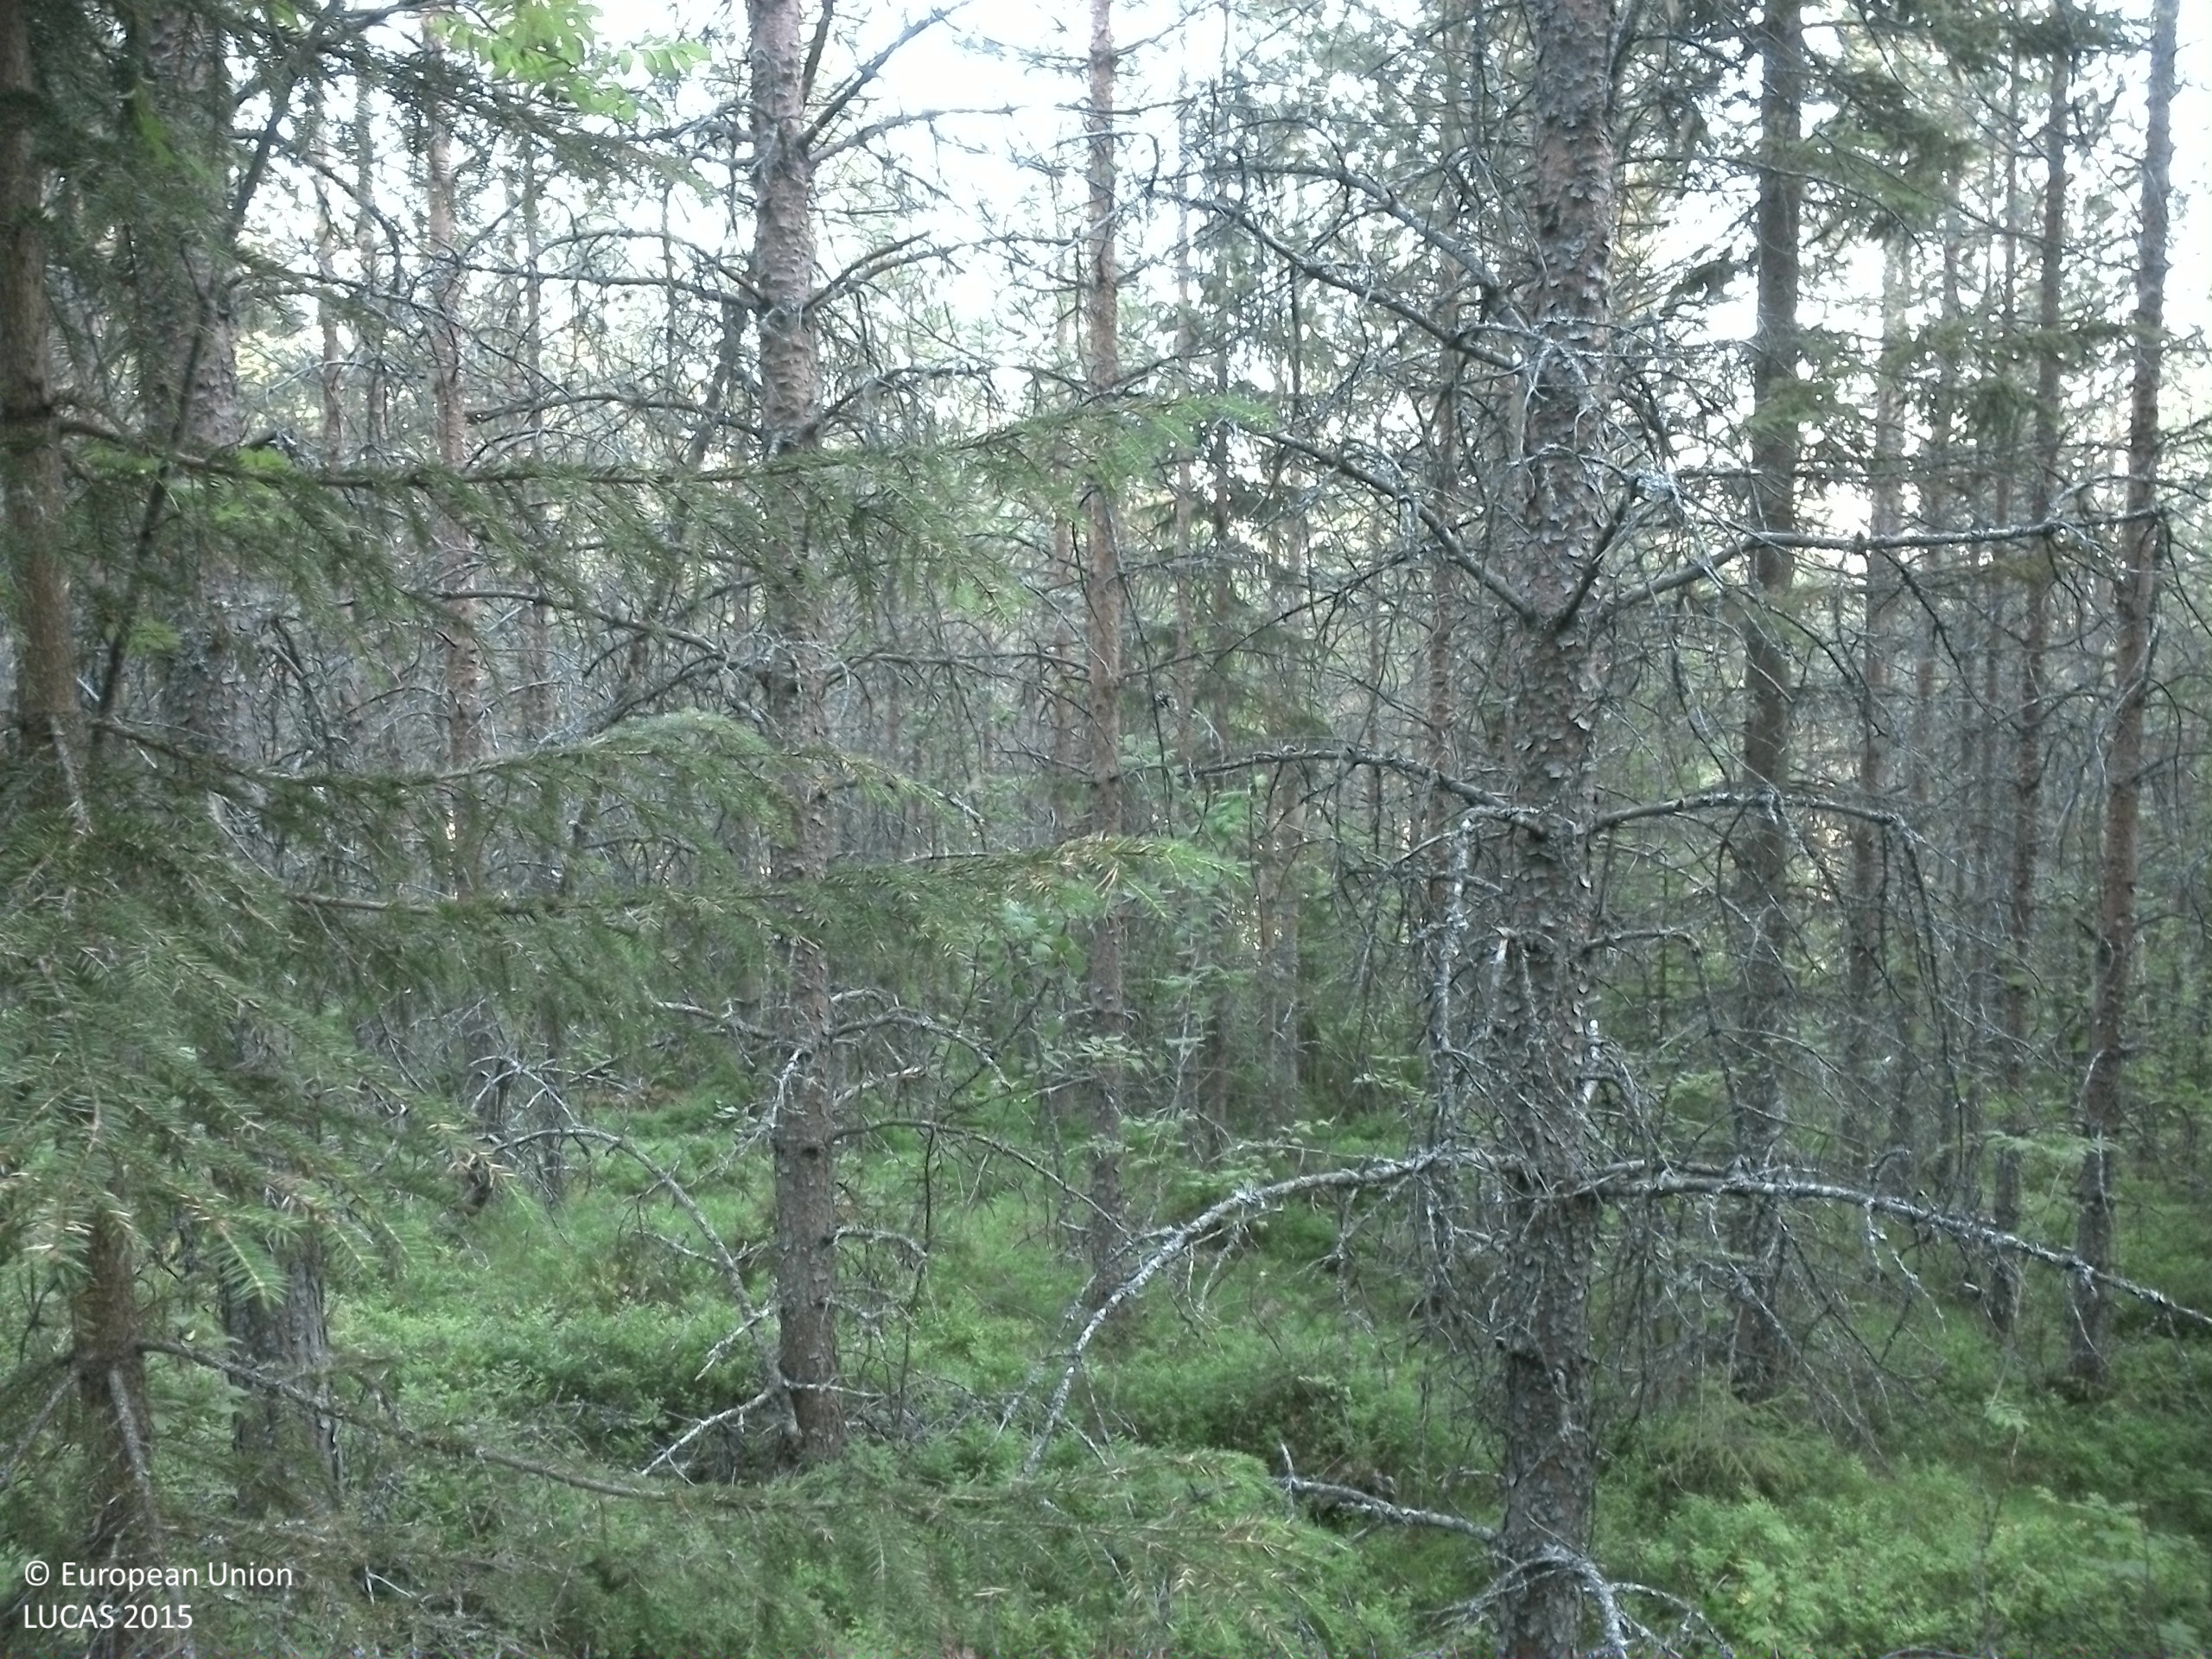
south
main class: Woodland
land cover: Pine dominated coniferous woodland
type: exotic forest
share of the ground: 50 - 75 %
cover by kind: coniferous forest trees 50 %, shrubs 45 %, broadleaved forest trees 5 %
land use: Forestry
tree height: > 5 m
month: August
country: SE
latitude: 63.7372
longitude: 17.3657
